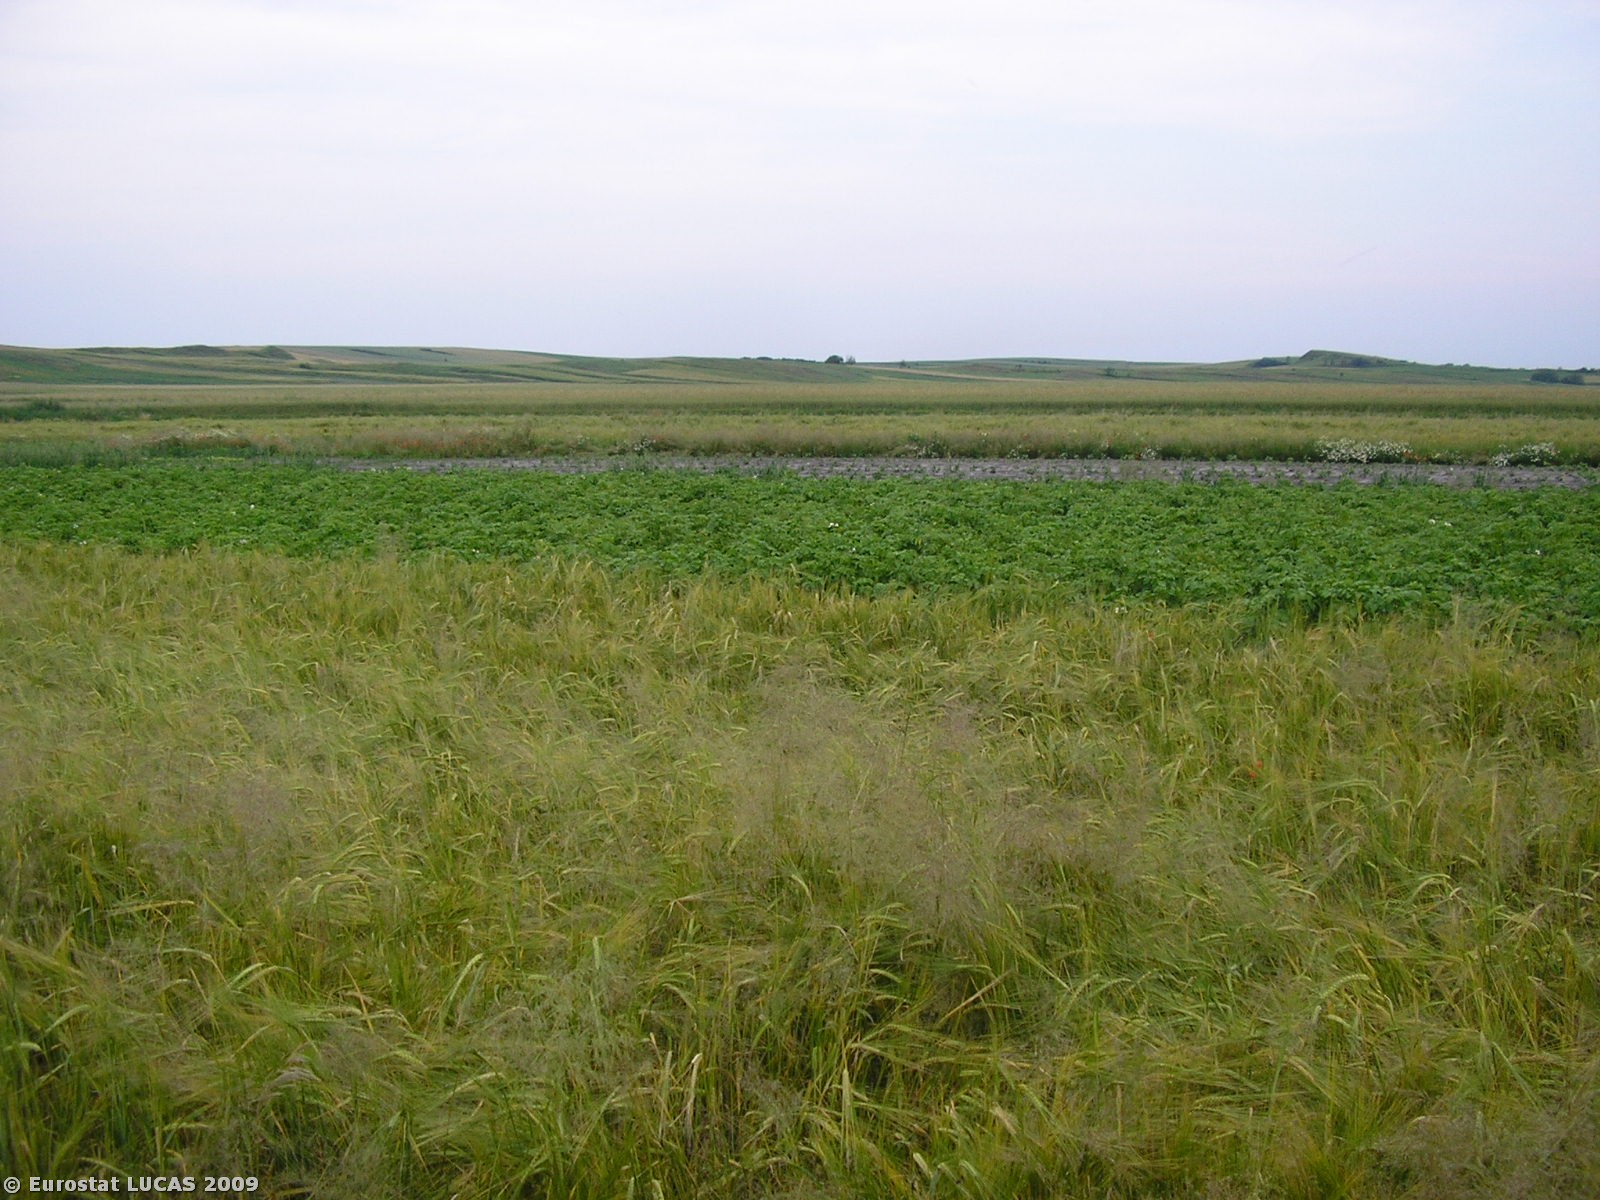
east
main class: Cropland
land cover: Barley
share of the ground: > 75 %
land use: Agriculture (excluding fallow land and kitchen gardens)
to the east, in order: Barley; Tracks; Potatoes; Other fresh vegetables; Grass margins; Tracks; Barley; Grass margins; Dry pulses; Tracks; Common wheat; Grass margins; Triticale; Tracks; Common wheat; Grass margins; Common wheat; Tracks; Grass margins; Other root crops; Potatoes; Grass margins; Common wheat; Tracks; Barley
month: June
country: PL
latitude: 50.4286
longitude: 20.6396
